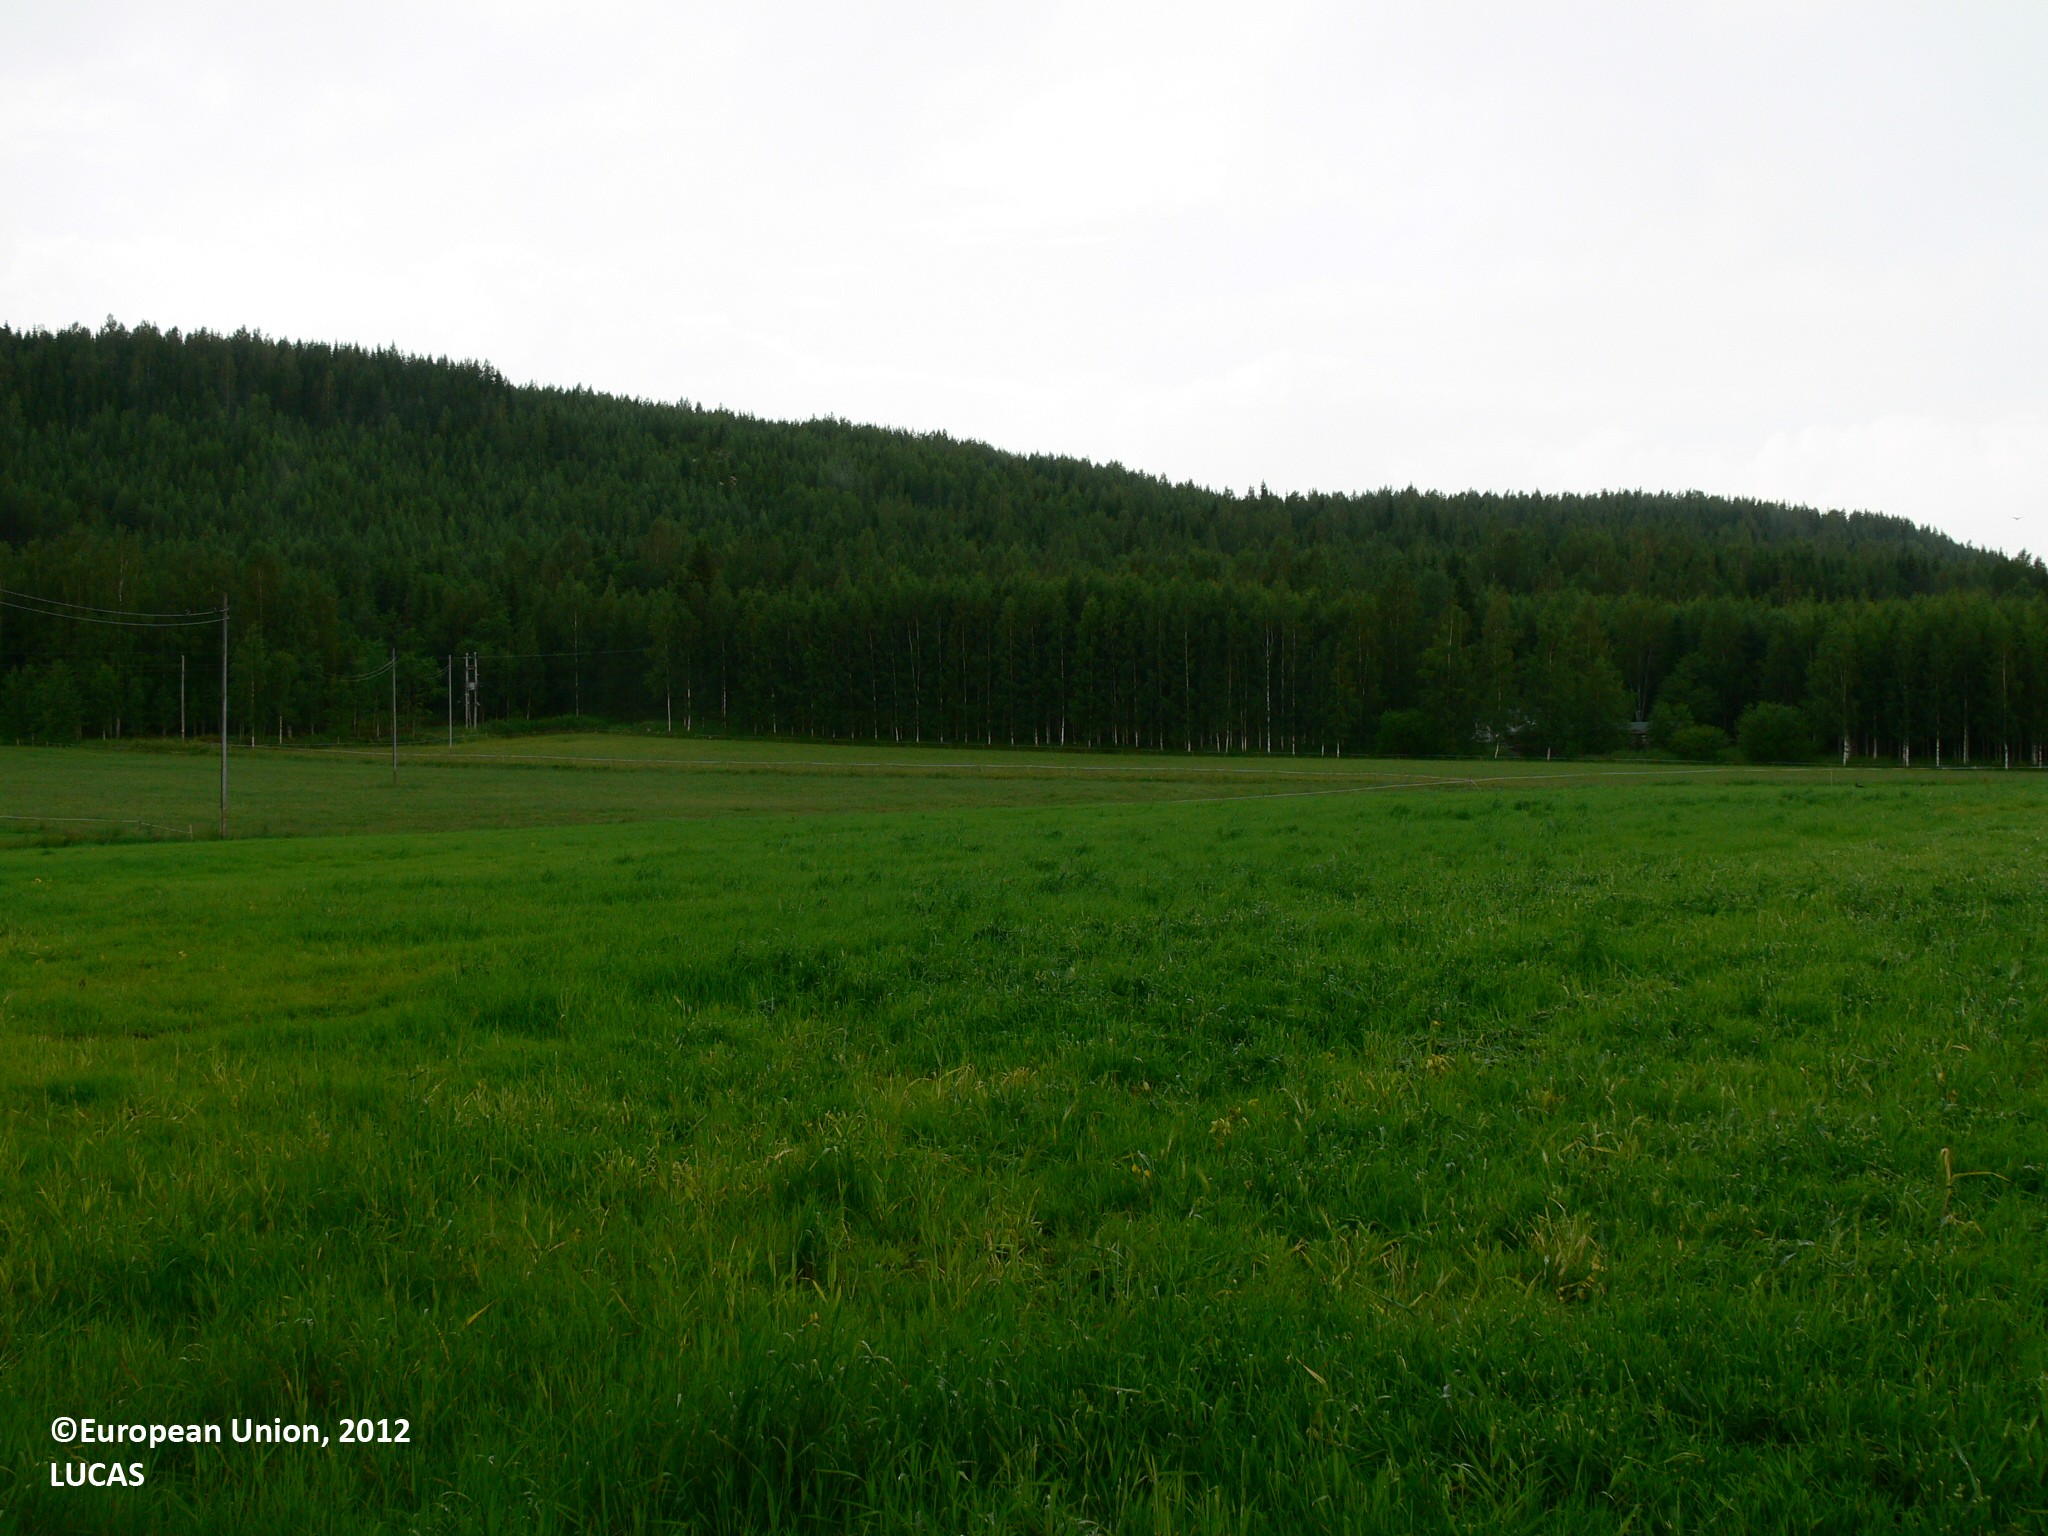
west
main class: Cropland
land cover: Temporary grasslands
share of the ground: > 75 %
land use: Agriculture (excluding fallow land and kitchen gardens)
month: July
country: FI
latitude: 63.2654
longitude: 30.0377
